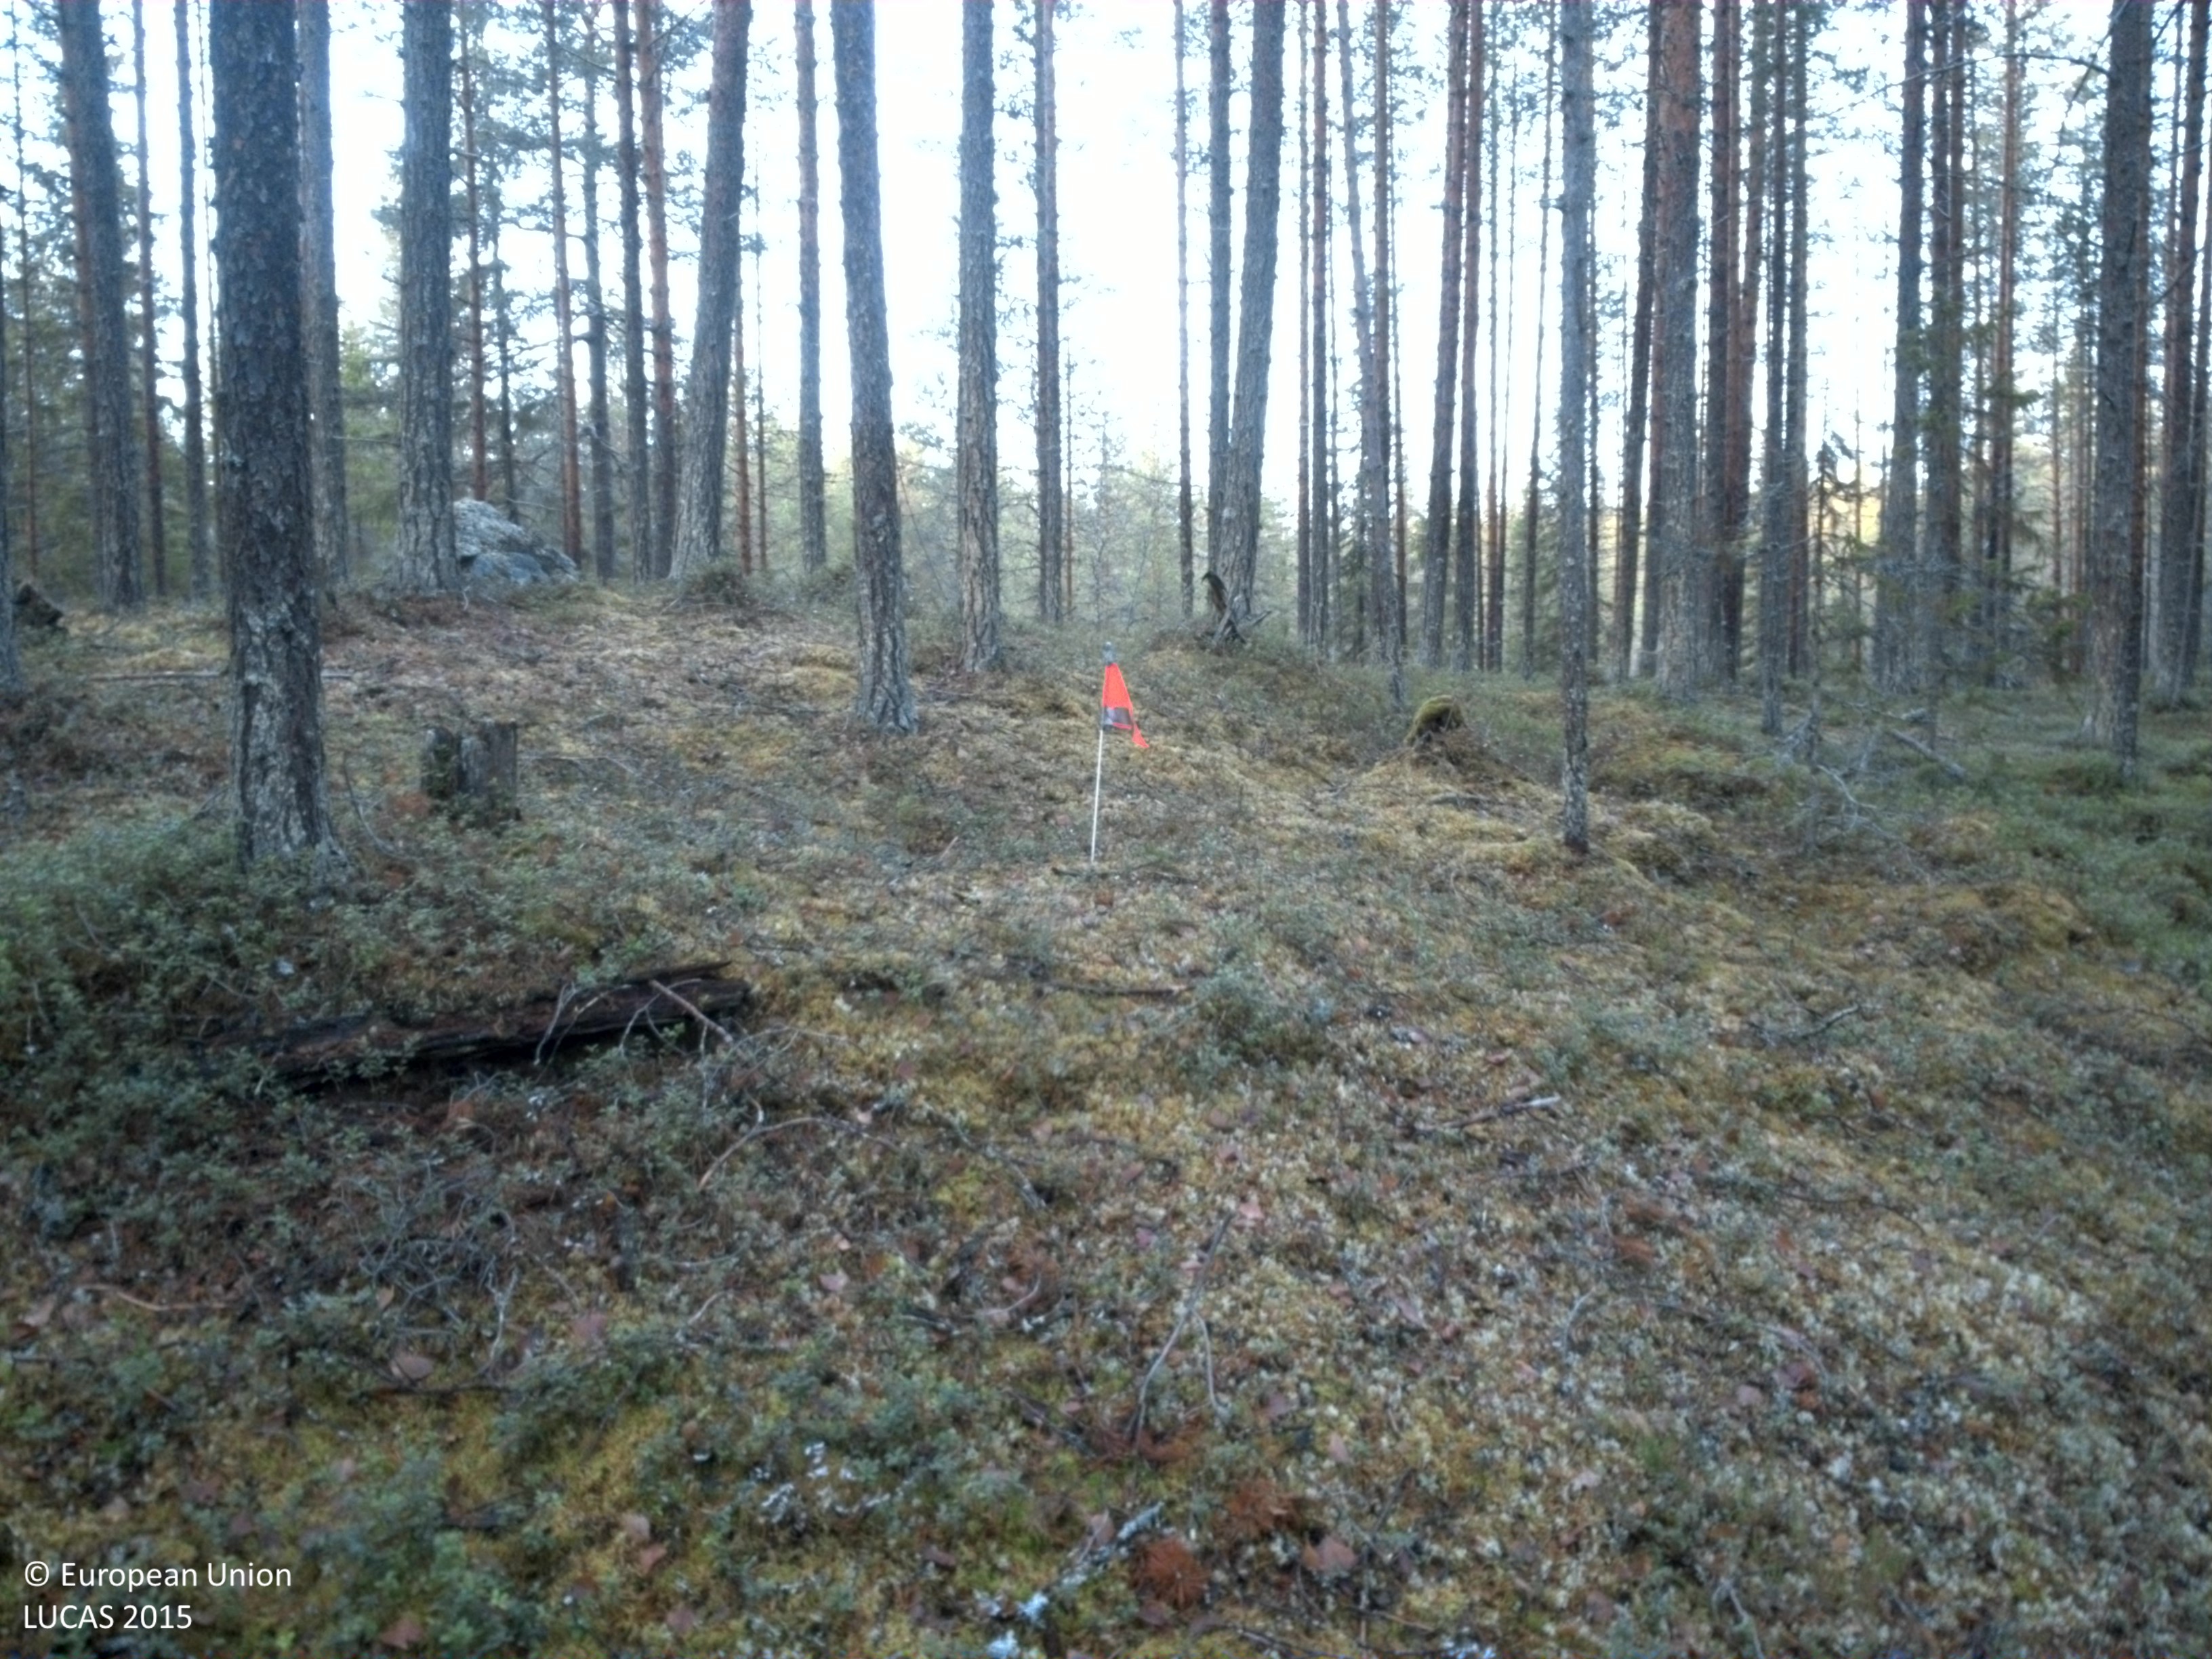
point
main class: Woodland
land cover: Pine dominated coniferous woodland
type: boreal forest
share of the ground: 25 - 50 %
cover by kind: coniferous forest trees 35 %, lichens and mosses 35 %, shrubs 30 %
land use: Forestry
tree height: > 5 m
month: October
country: SE
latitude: 64.3943
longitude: 16.8740
